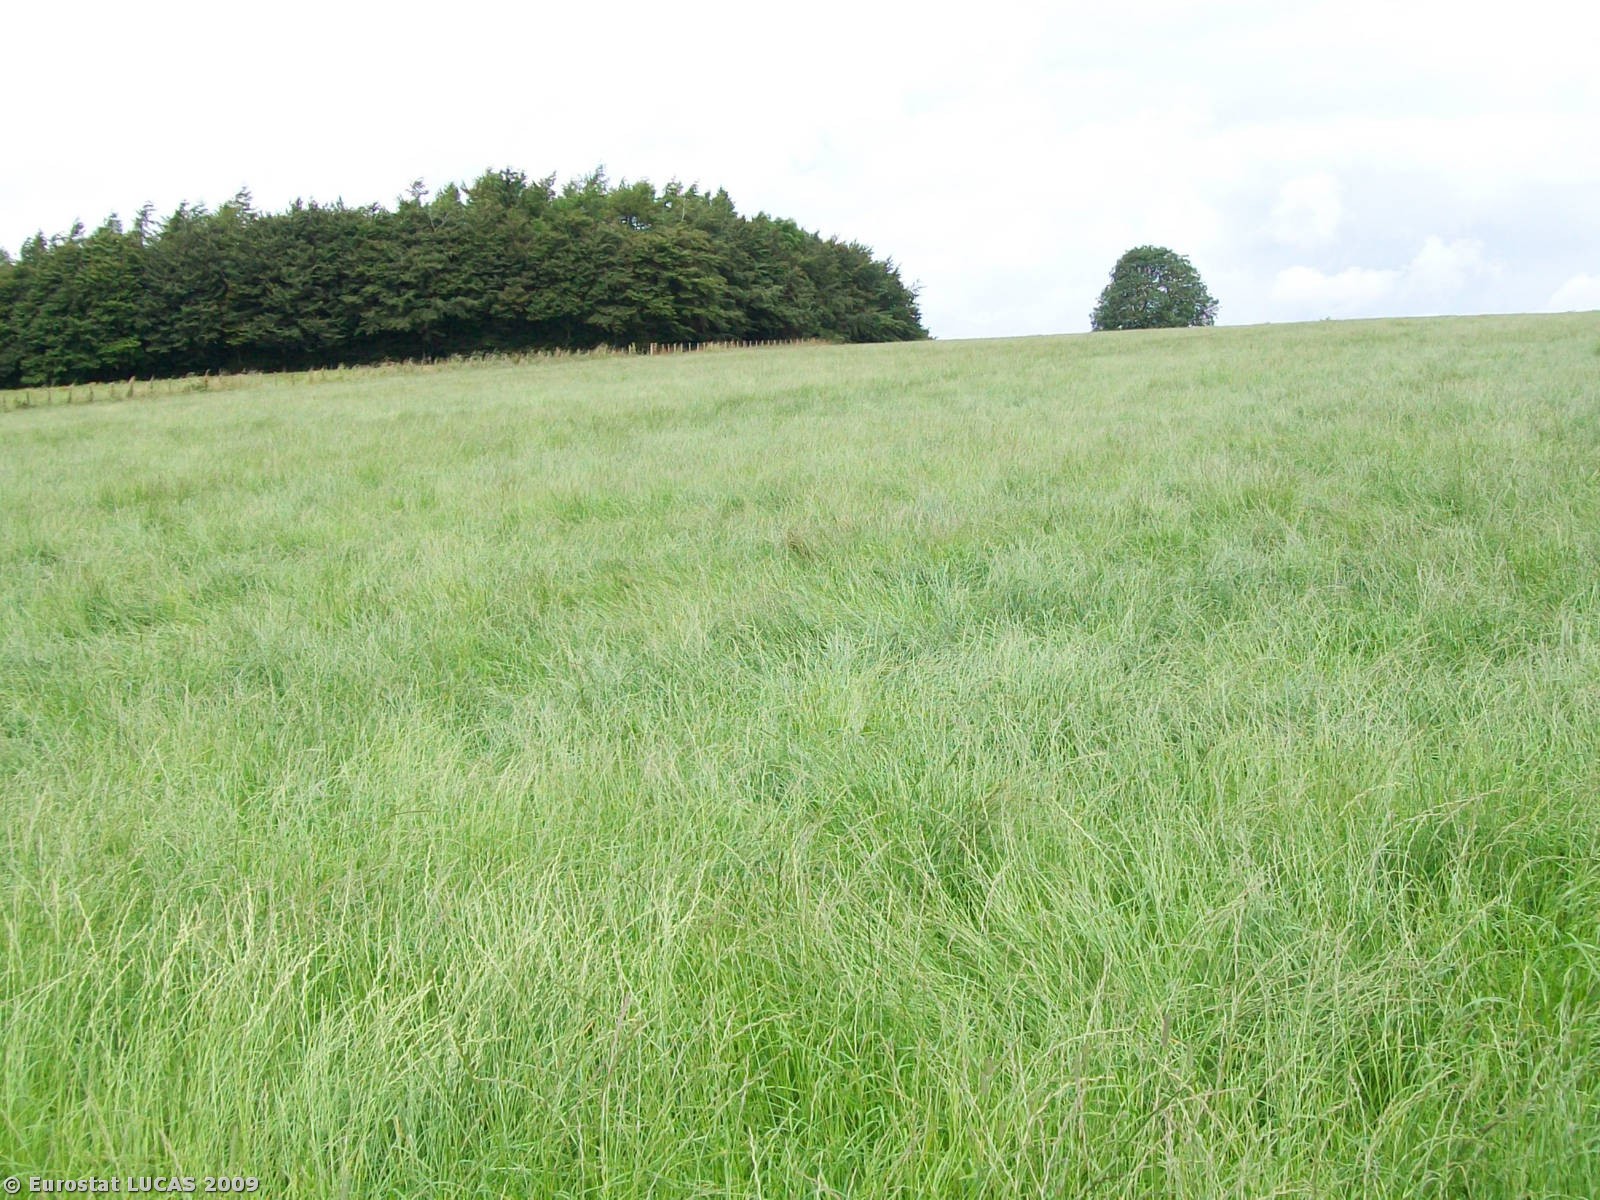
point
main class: Grassland
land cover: Grassland without tree/shrub cover
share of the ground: > 75 %
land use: Agriculture (excluding fallow land and kitchen gardens)
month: July
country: GB
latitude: 55.0705
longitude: -3.3099
